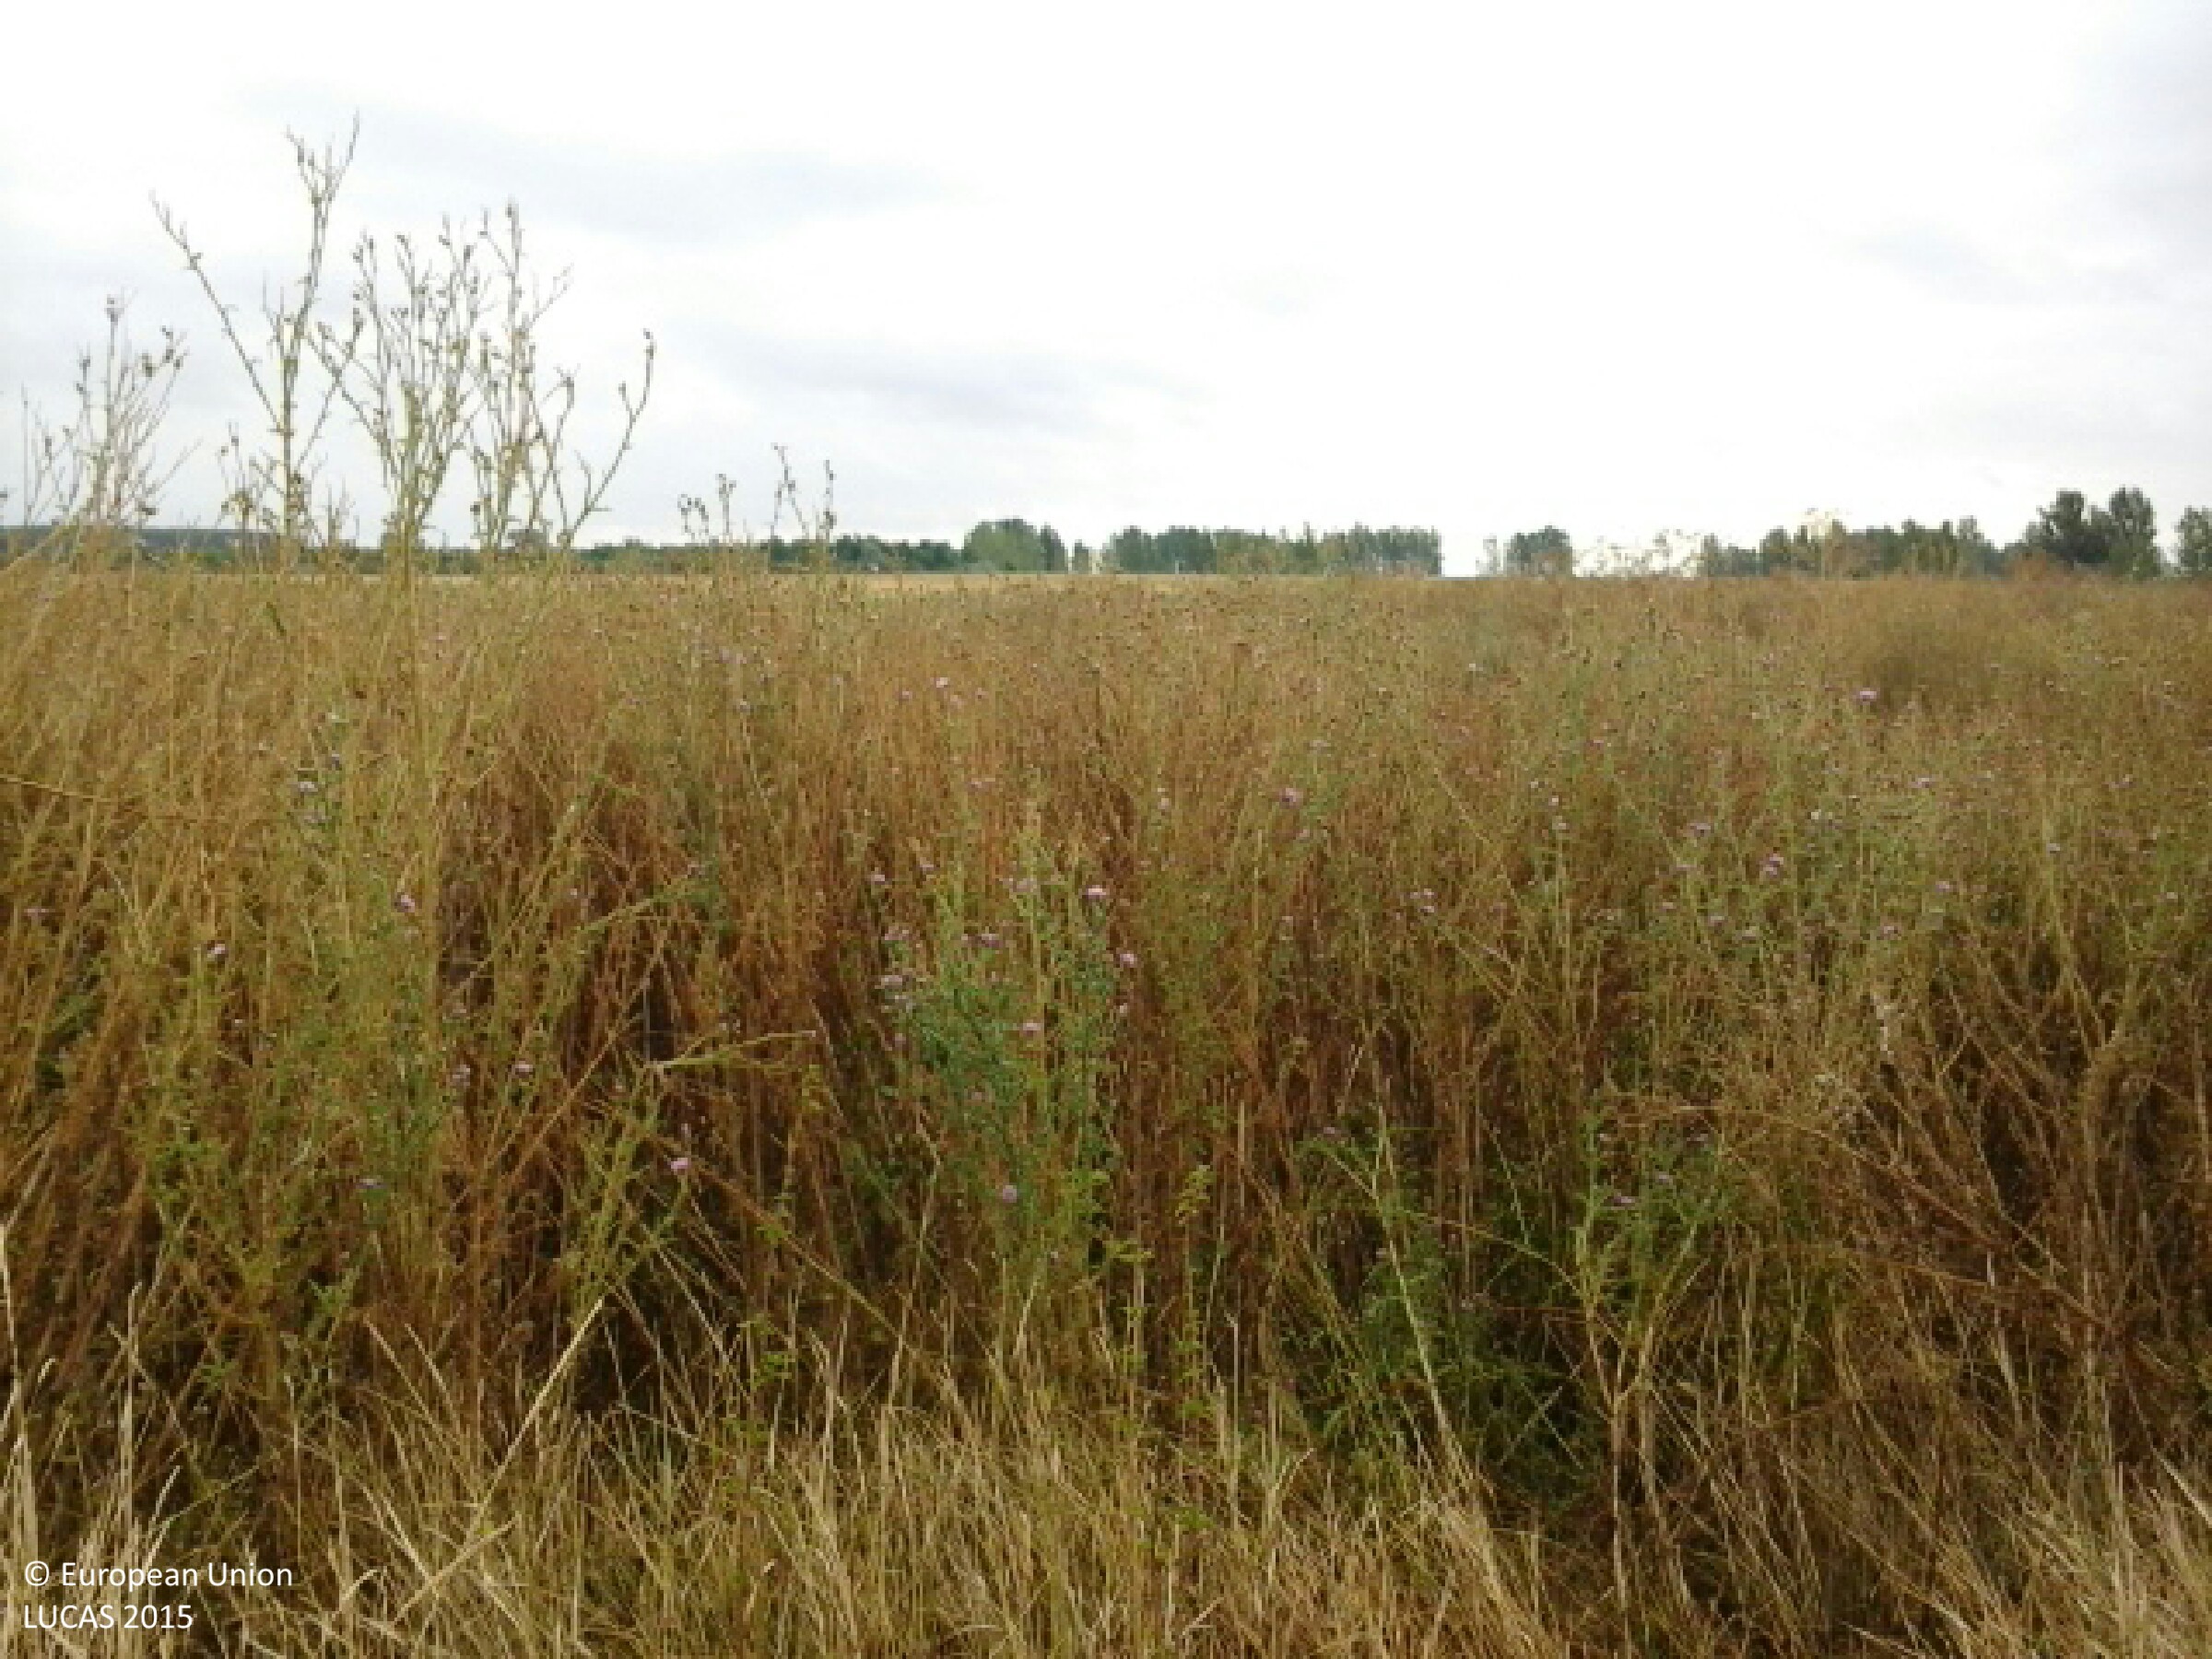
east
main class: Grassland
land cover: Spontaneously vegetated surfaces
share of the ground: > 75 %
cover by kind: herbaceous plants 100 %
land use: Semi-natural and natural areas not in use
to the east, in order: Spontaneously vegetated surfaces; Maize; Sunflower
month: August
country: HU
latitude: 47.1562
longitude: 21.5831
